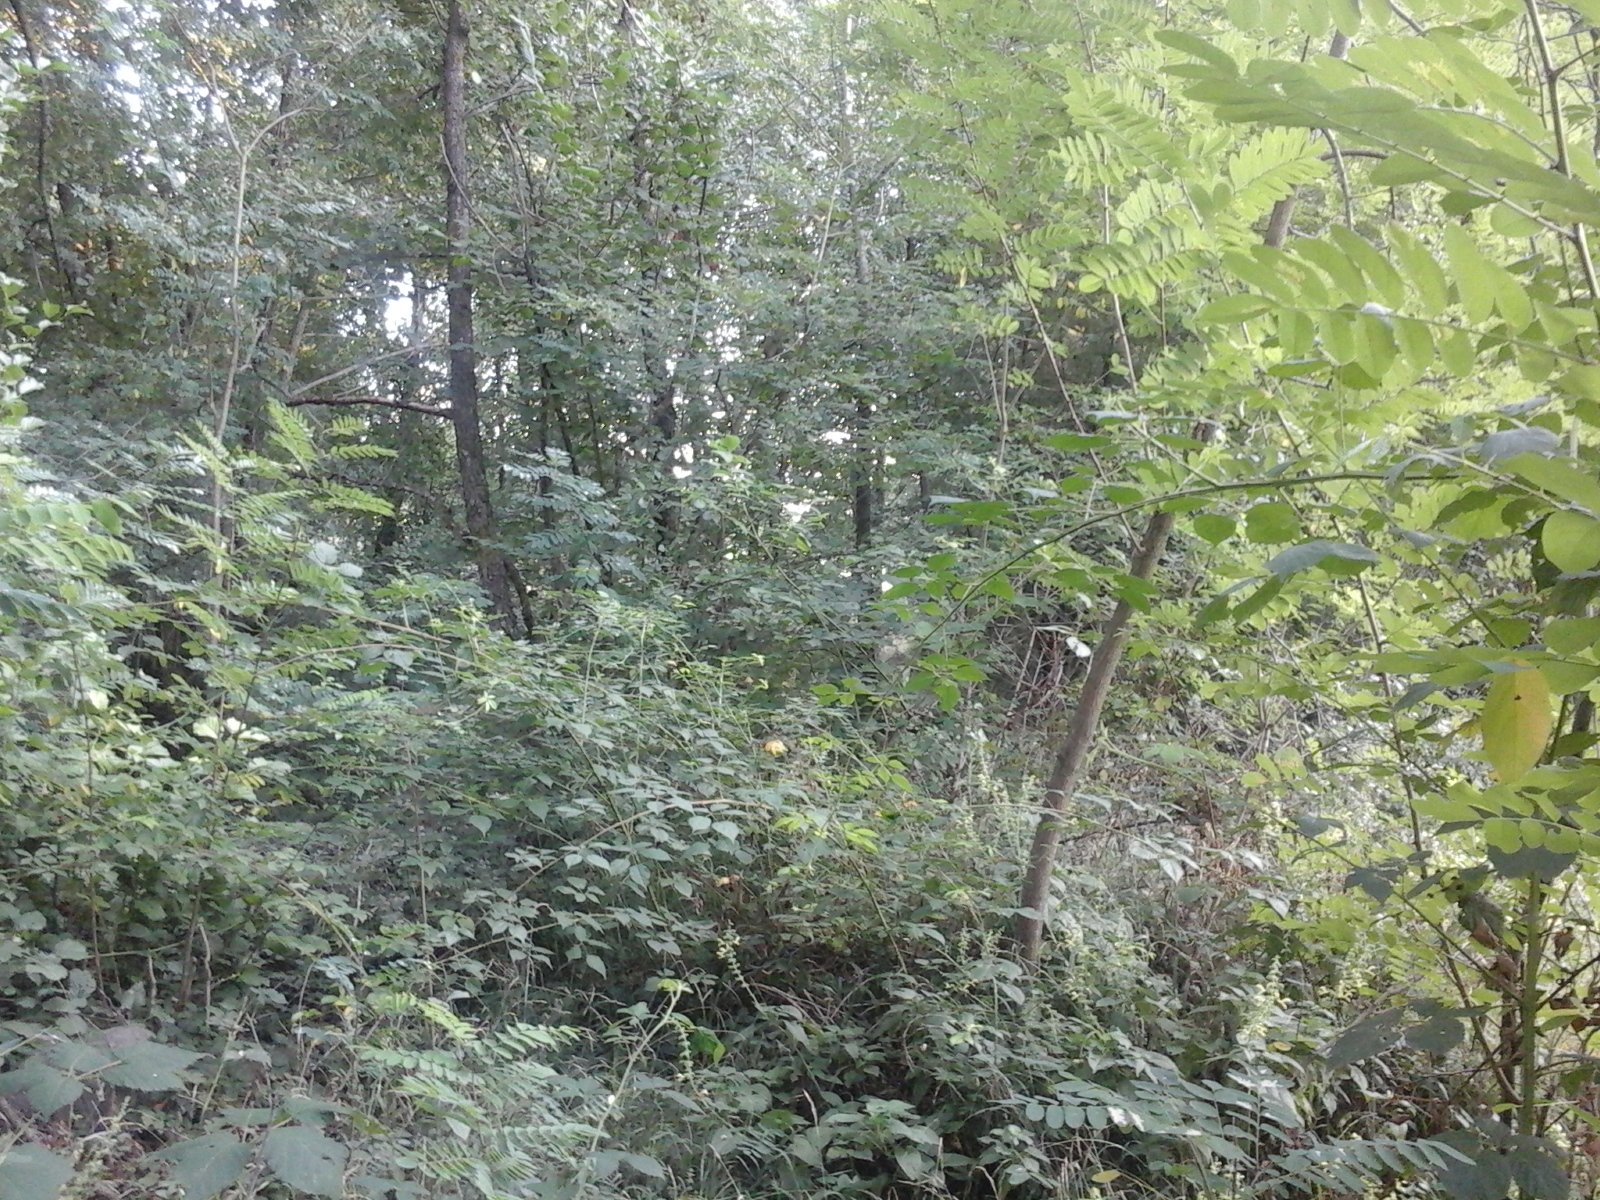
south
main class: Woodland
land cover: Broadleaved woodland
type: exotic forest
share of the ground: > 75 %
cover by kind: broadleaved forest trees 100 %
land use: Forestry
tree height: > 5 m
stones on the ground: < 10 %
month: September
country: RO
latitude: 47.9419
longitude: 23.4496
